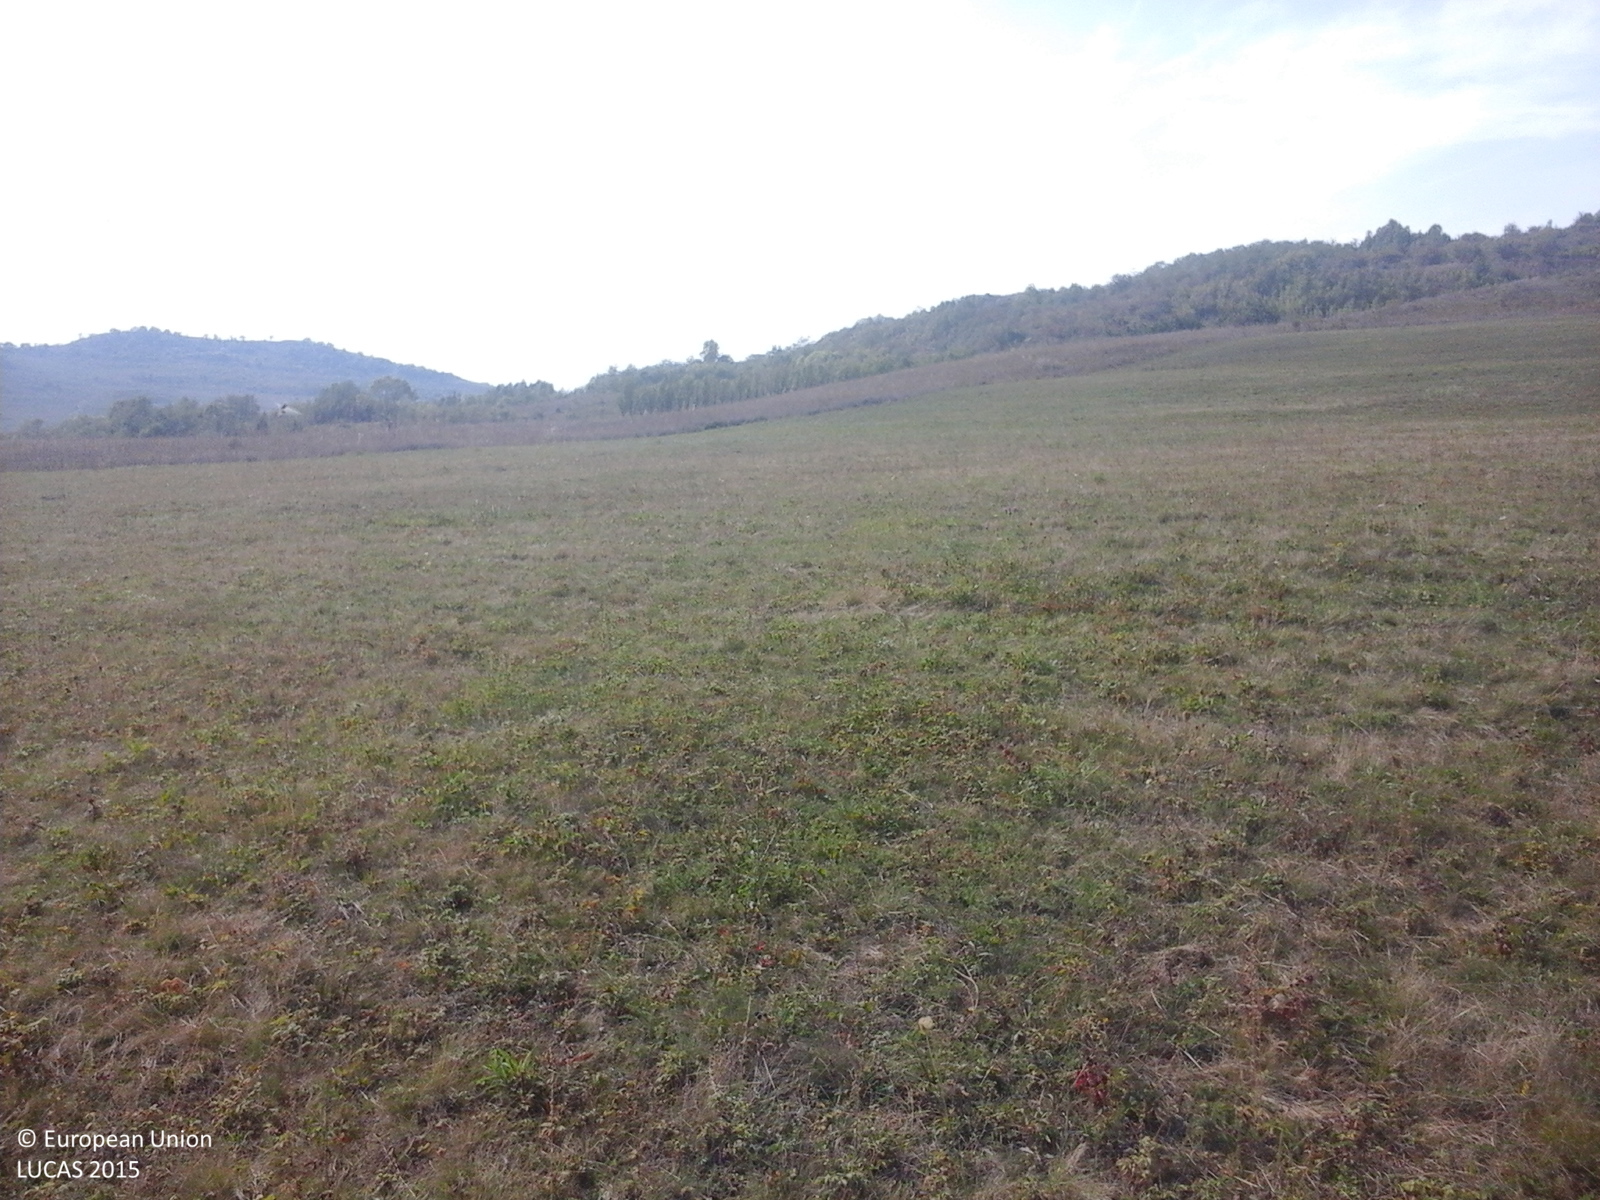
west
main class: Grassland
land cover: Grassland without tree/shrub cover
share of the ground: > 75 %
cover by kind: herbaceous plants 100 %
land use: Agriculture (excluding fallow land and kitchen gardens)
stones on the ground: < 10 %
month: September
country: RO
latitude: 47.1269
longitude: 23.6924
